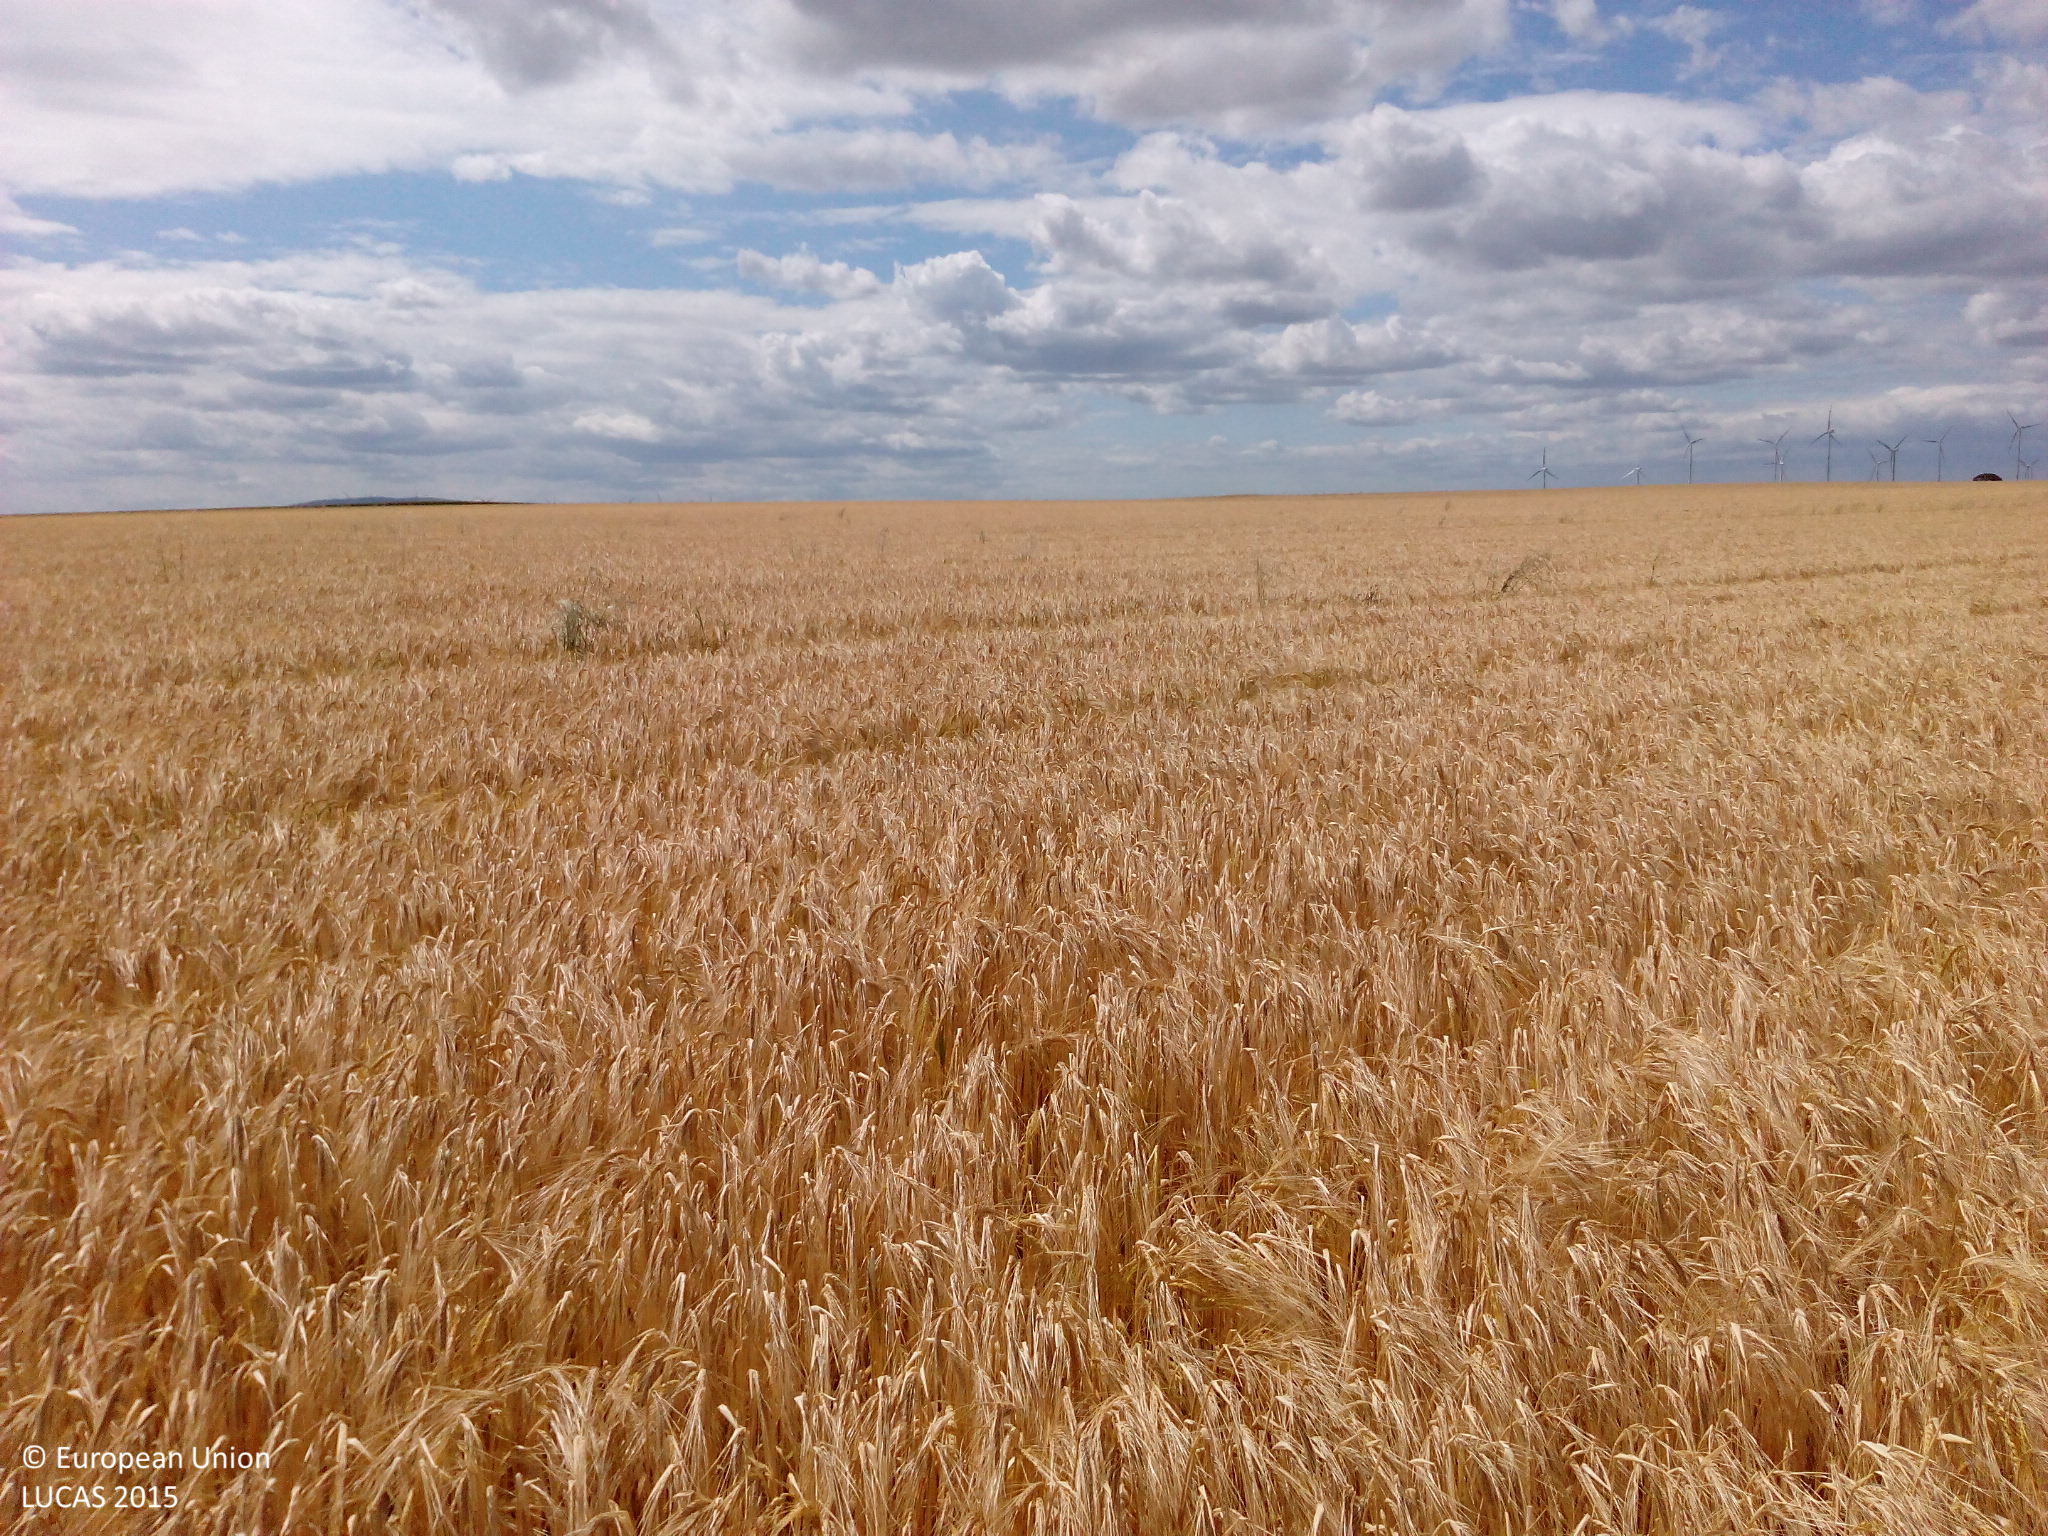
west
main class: Cropland
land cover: Barley
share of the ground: > 75 %
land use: Agriculture (excluding fallow land and kitchen gardens)
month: July
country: DE
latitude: 49.6657
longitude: 8.1578
